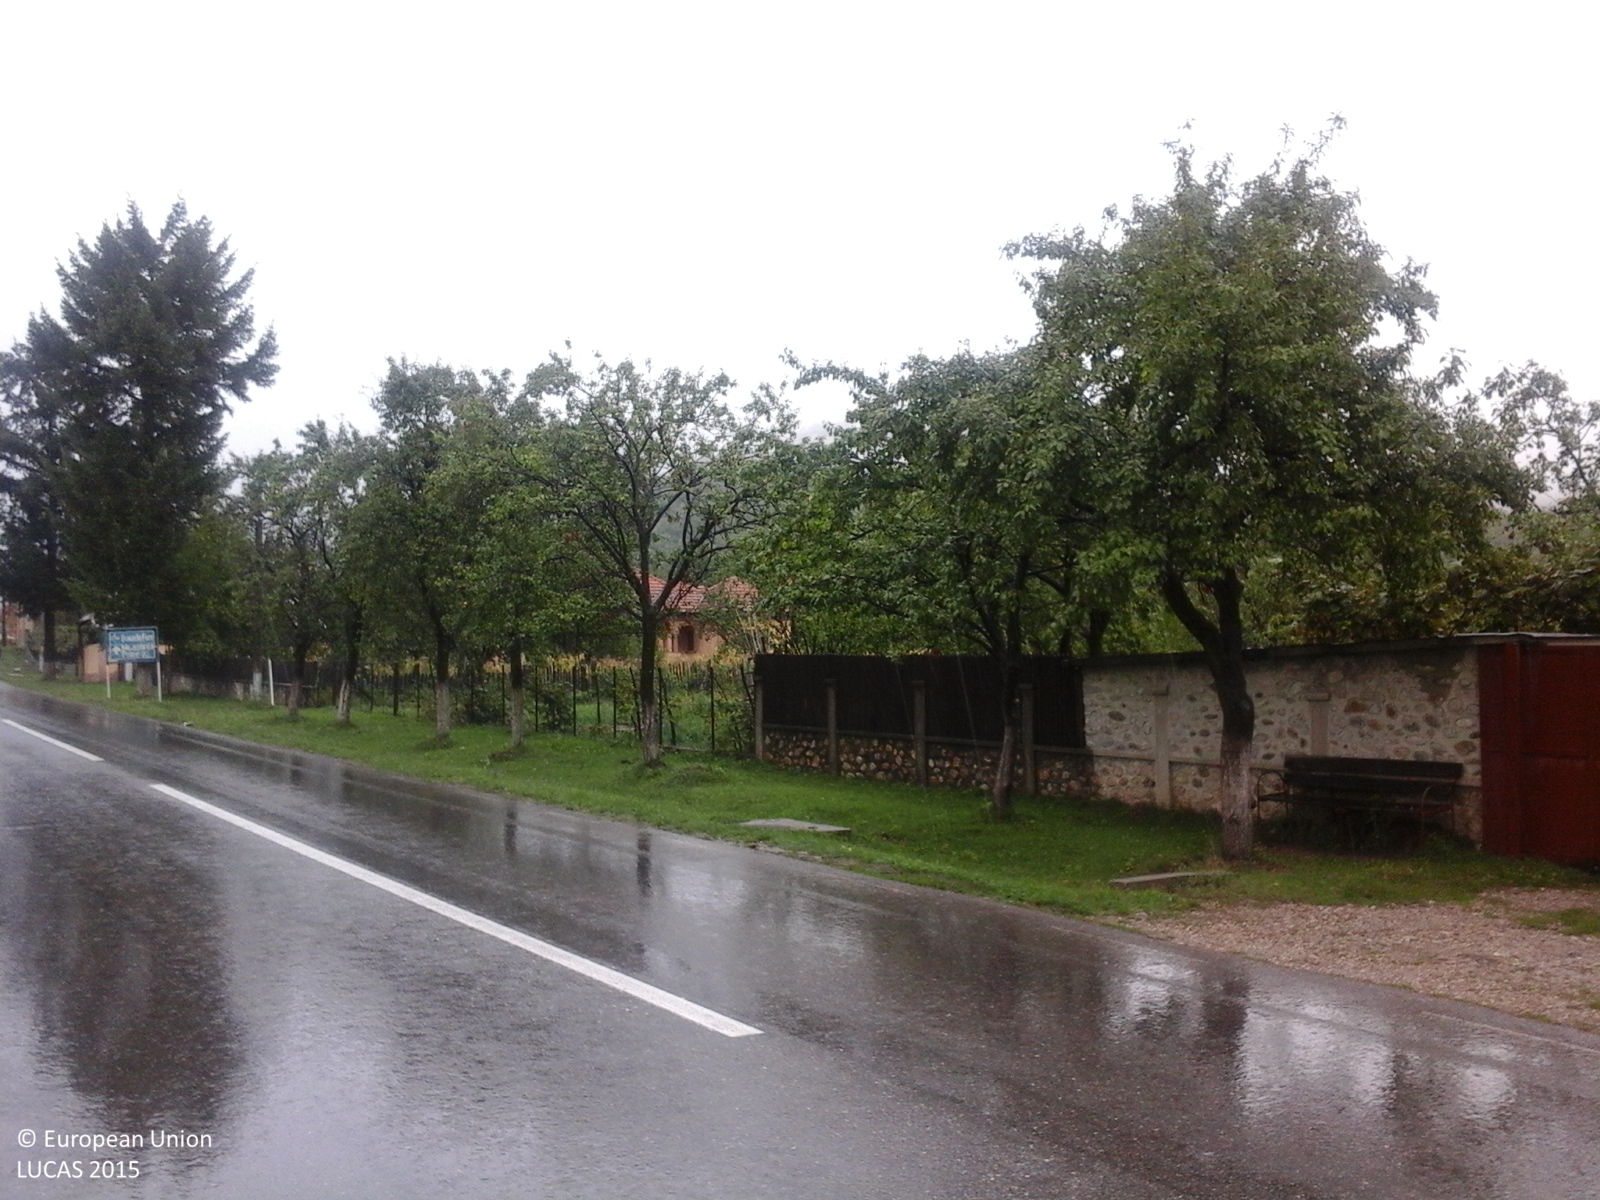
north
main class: Grassland
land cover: Spontaneously vegetated surfaces
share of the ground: > 75 %
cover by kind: herbaceous plants 100 %
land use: Agriculture (excluding fallow land and kitchen gardens)
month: September
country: RO
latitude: 45.1783
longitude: 23.7944
